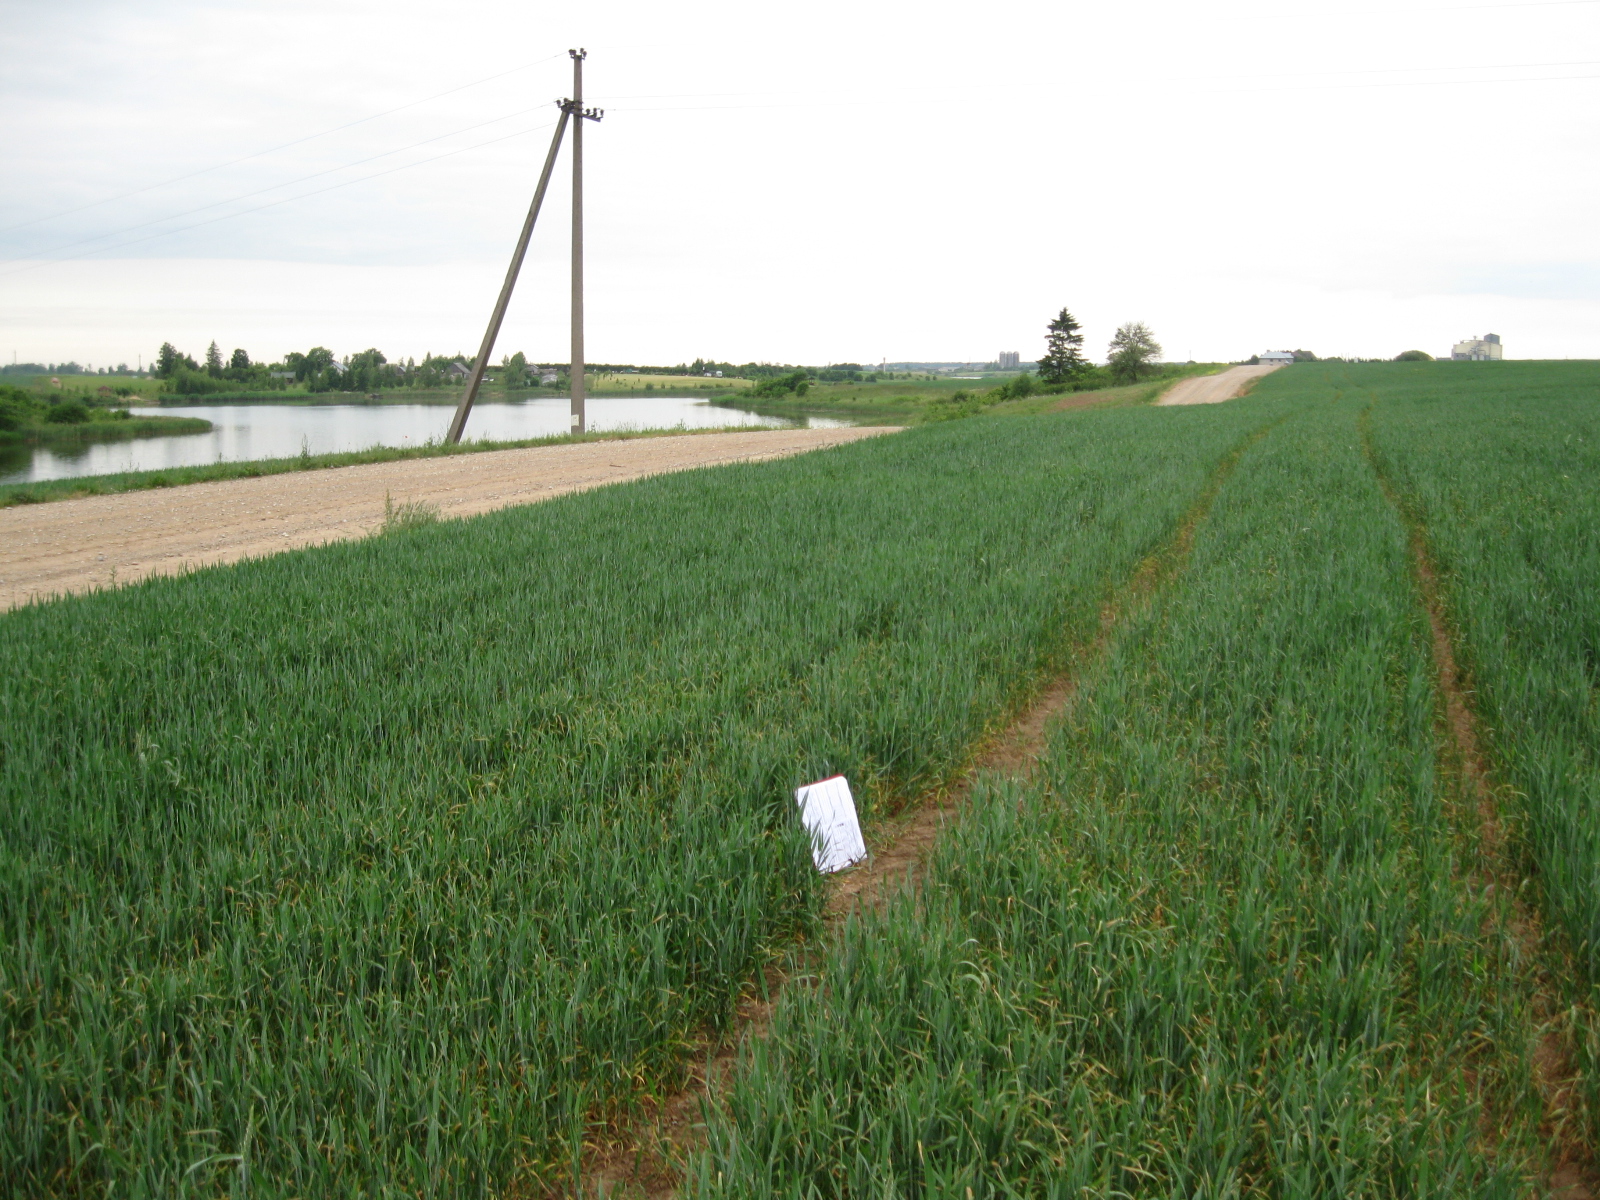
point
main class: Cropland
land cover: Common wheat
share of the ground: > 75 %
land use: Agriculture (excluding fallow land and kitchen gardens)
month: June
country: LT
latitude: 55.1189
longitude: 23.8699
